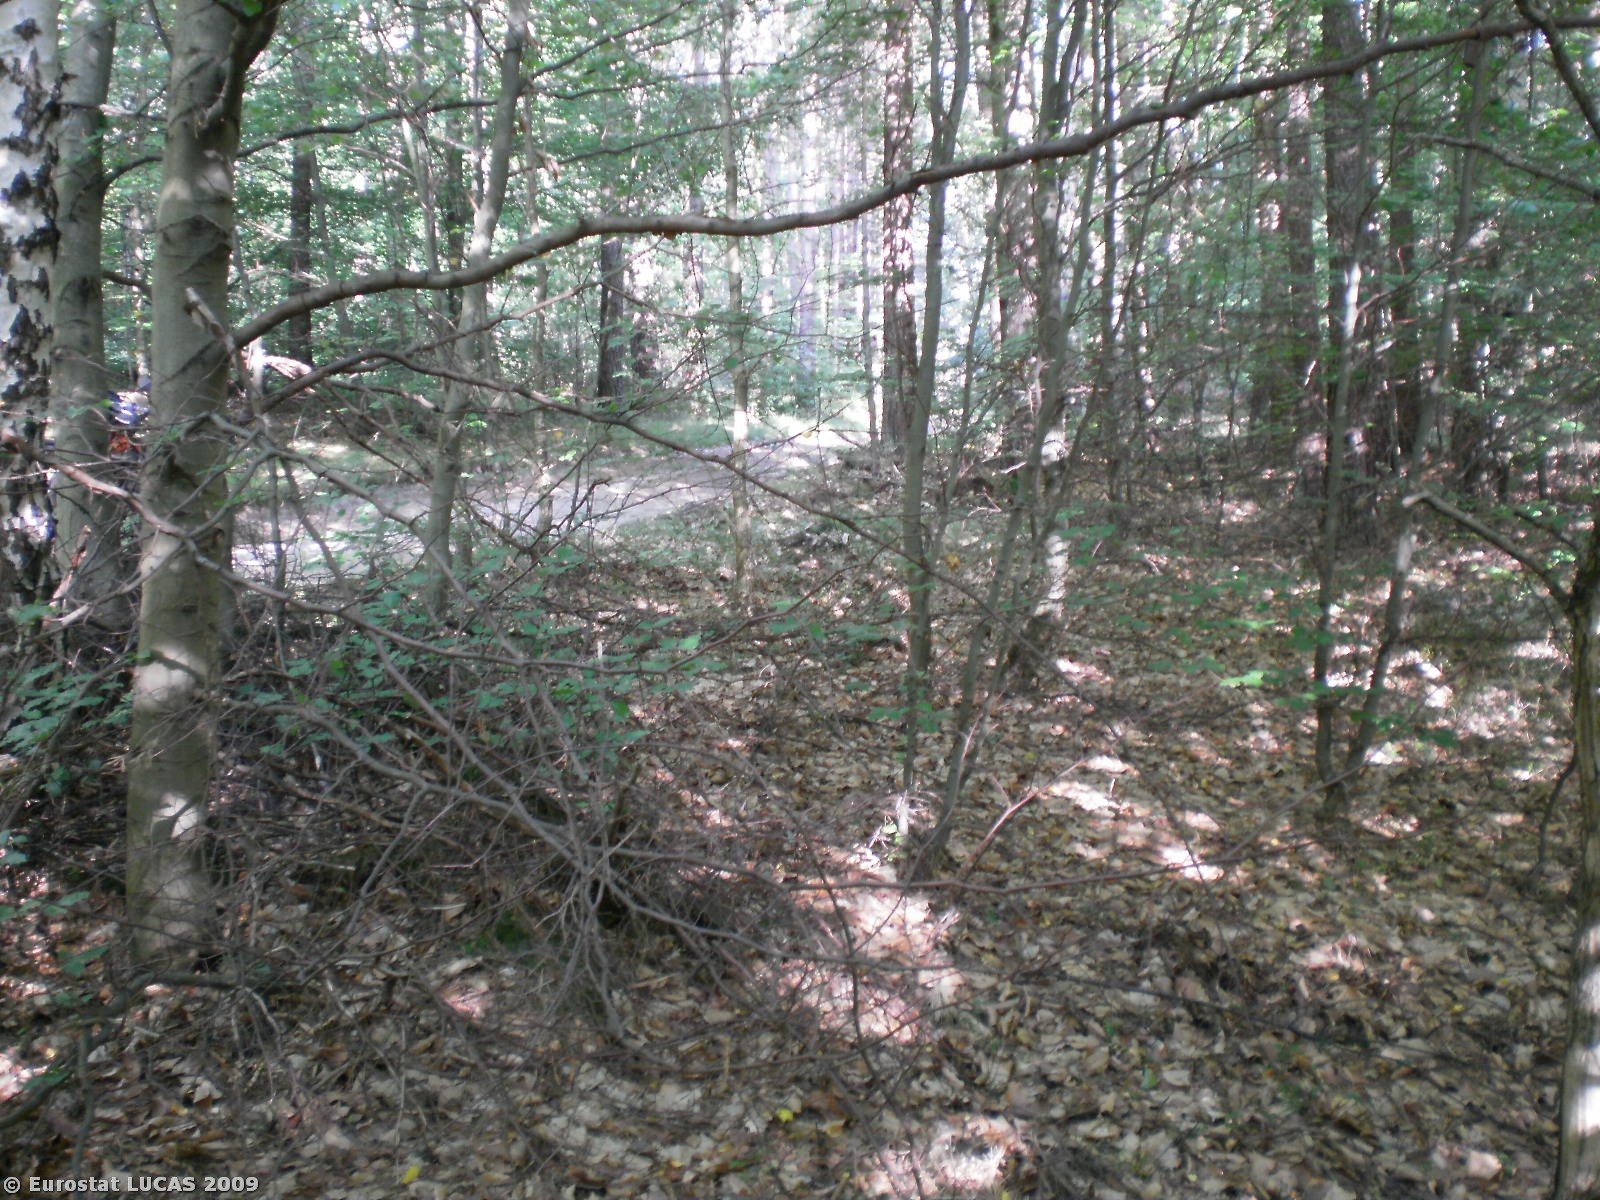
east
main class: Woodland
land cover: Mixed woodland
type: hemiboreal forest and nemoral coniferous forest and mixed broadleaved-coniferous forest
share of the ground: > 75 %
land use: Forestry
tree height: > 5 m
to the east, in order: Mixed woodland; Tracks; Mixed woodland; Coniferous woodland
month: July
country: PL
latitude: 54.0719
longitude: 17.7913
